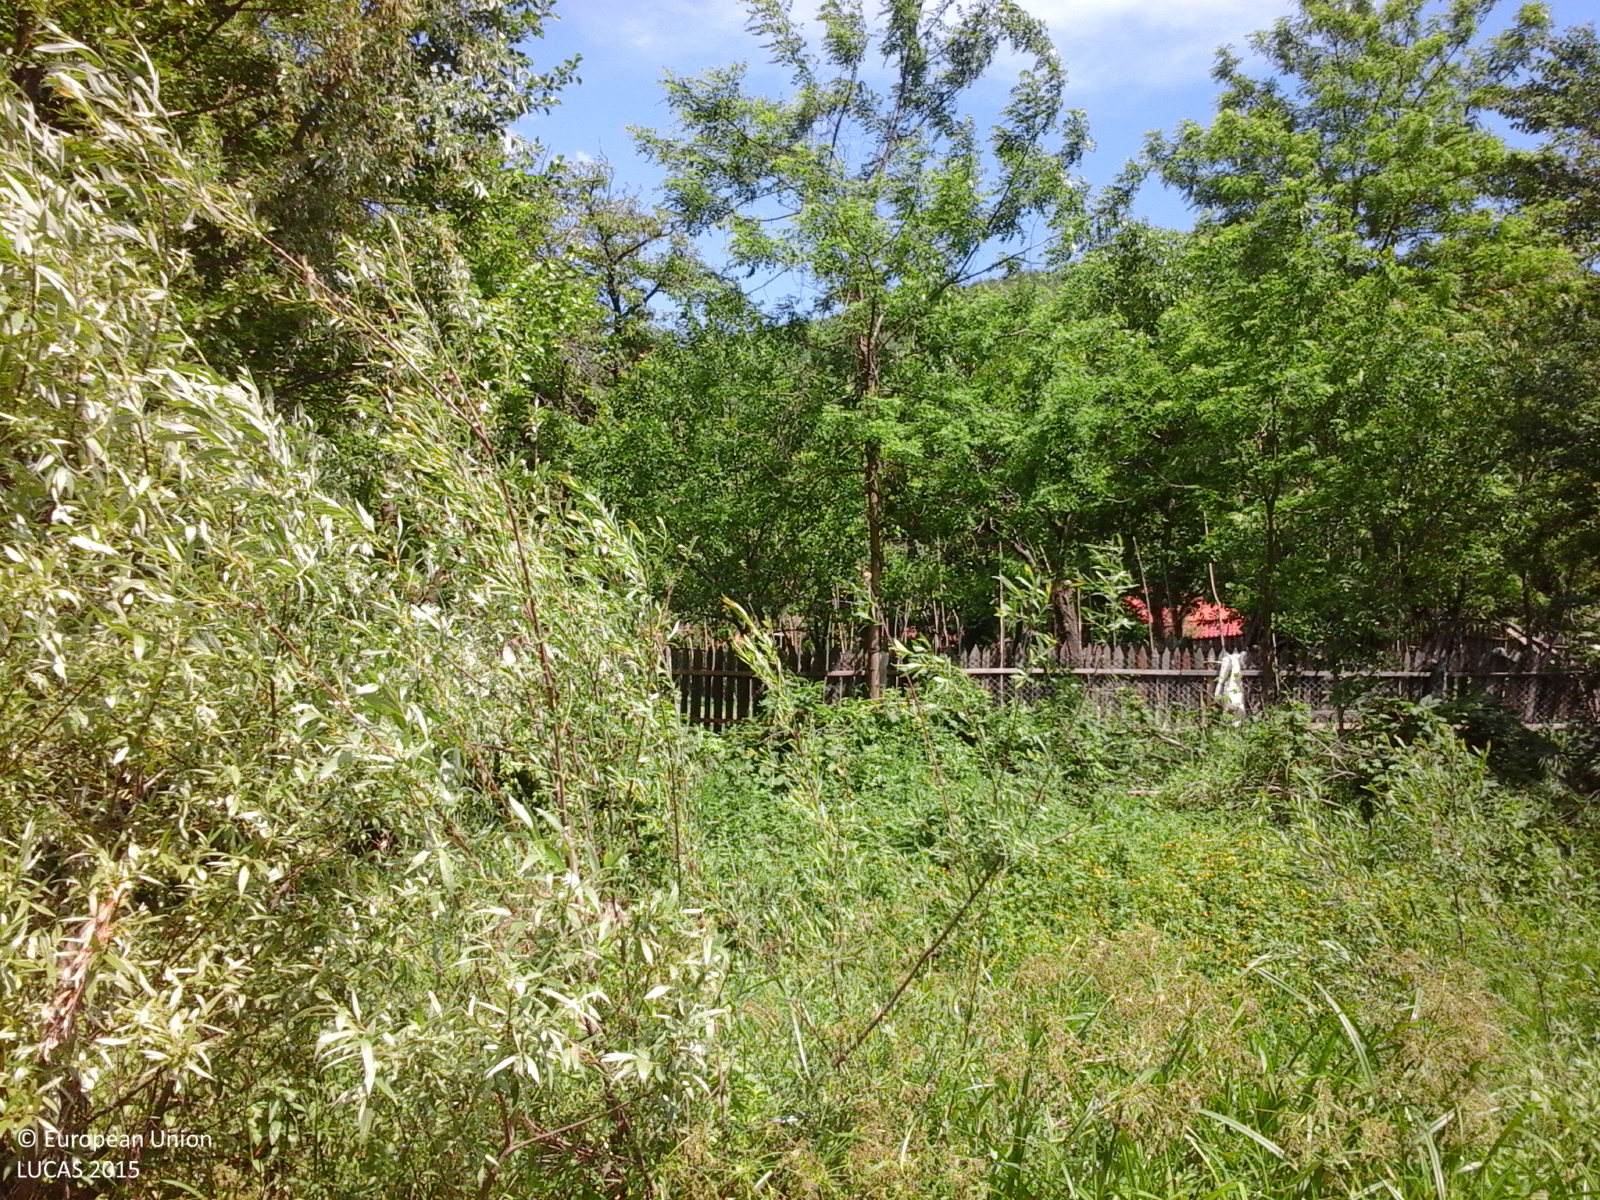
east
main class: Shrubland
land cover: Shrubland with sparse tree cover
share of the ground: > 75 %
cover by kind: shrubs 95 %, broadleaved forest trees 5 %
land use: Semi-natural and natural areas not in use
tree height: > 5 m
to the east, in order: Shrubland with sparse tree cover; Inland fresh running water; Grassland with sparse tree/shrub cover; Tracks; Grass margins; Lines of trees; Fences; Artificial constructions in urban areas; Broadleaved woodland
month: May
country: RO
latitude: 45.3545
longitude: 26.3704
